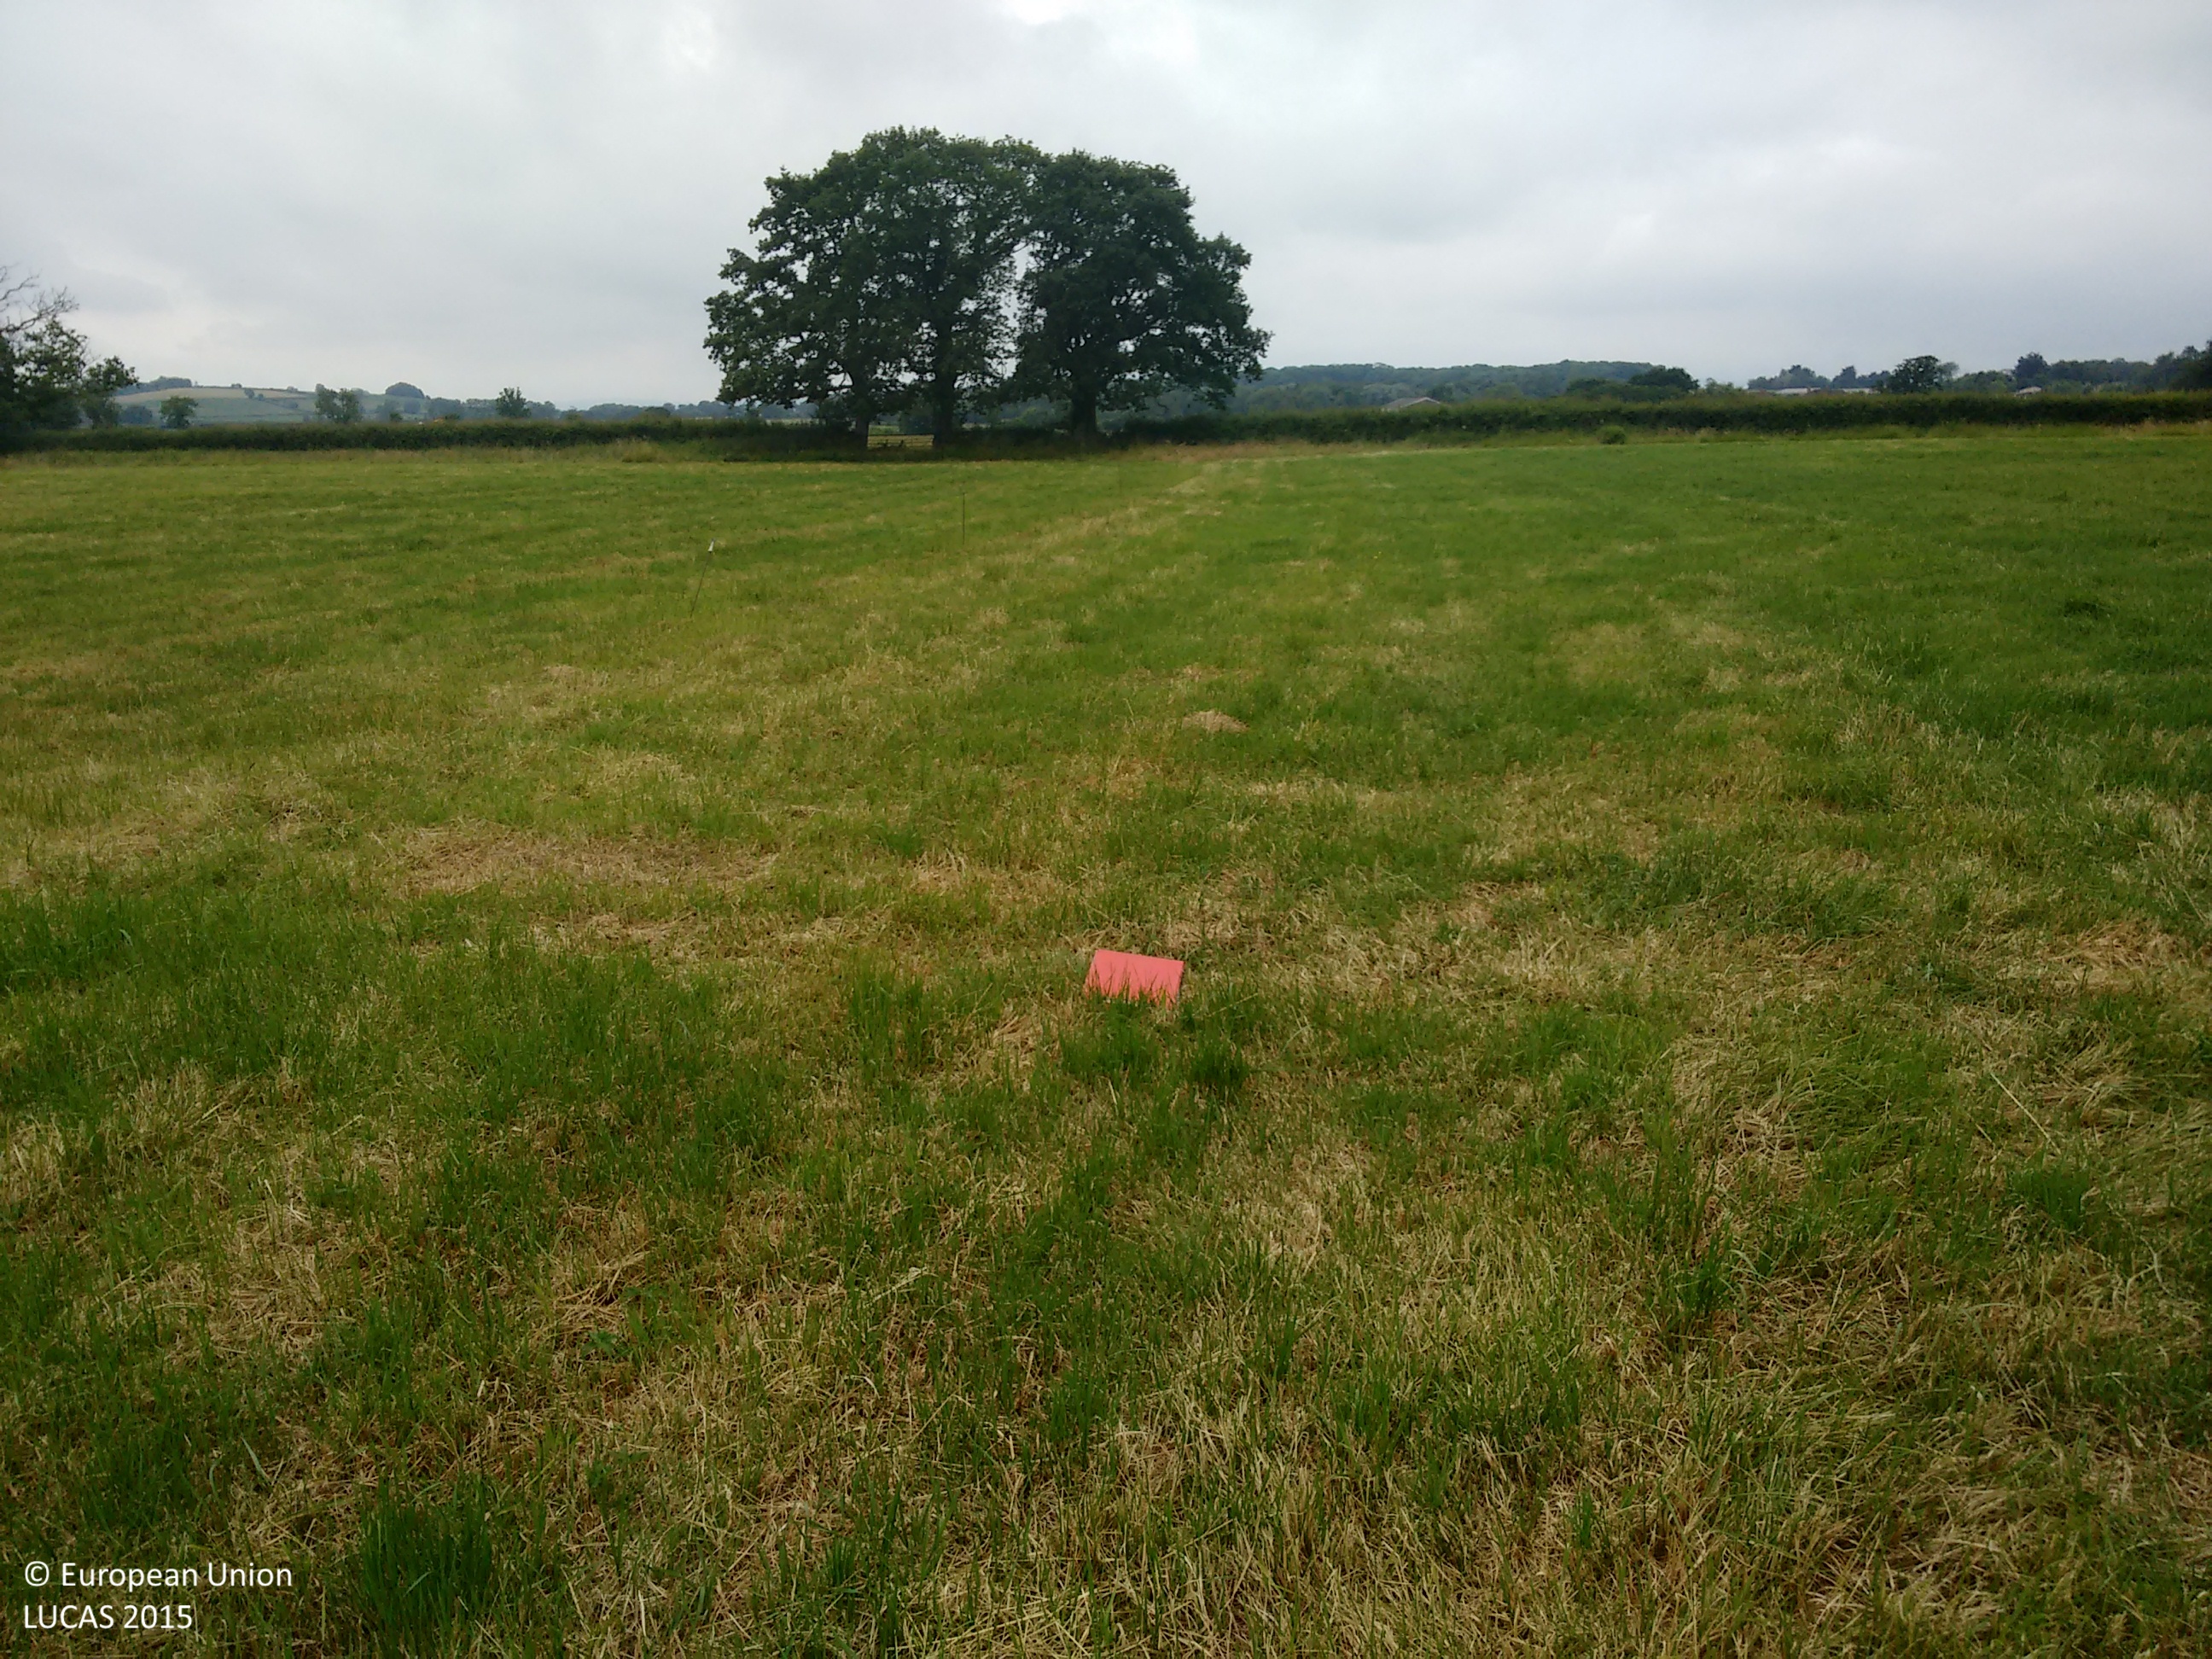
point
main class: Cropland
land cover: Temporary grasslands
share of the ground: > 75 %
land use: Agriculture (excluding fallow land and kitchen gardens)
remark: Harvested field
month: June
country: GB
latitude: 50.9802
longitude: -2.8777
